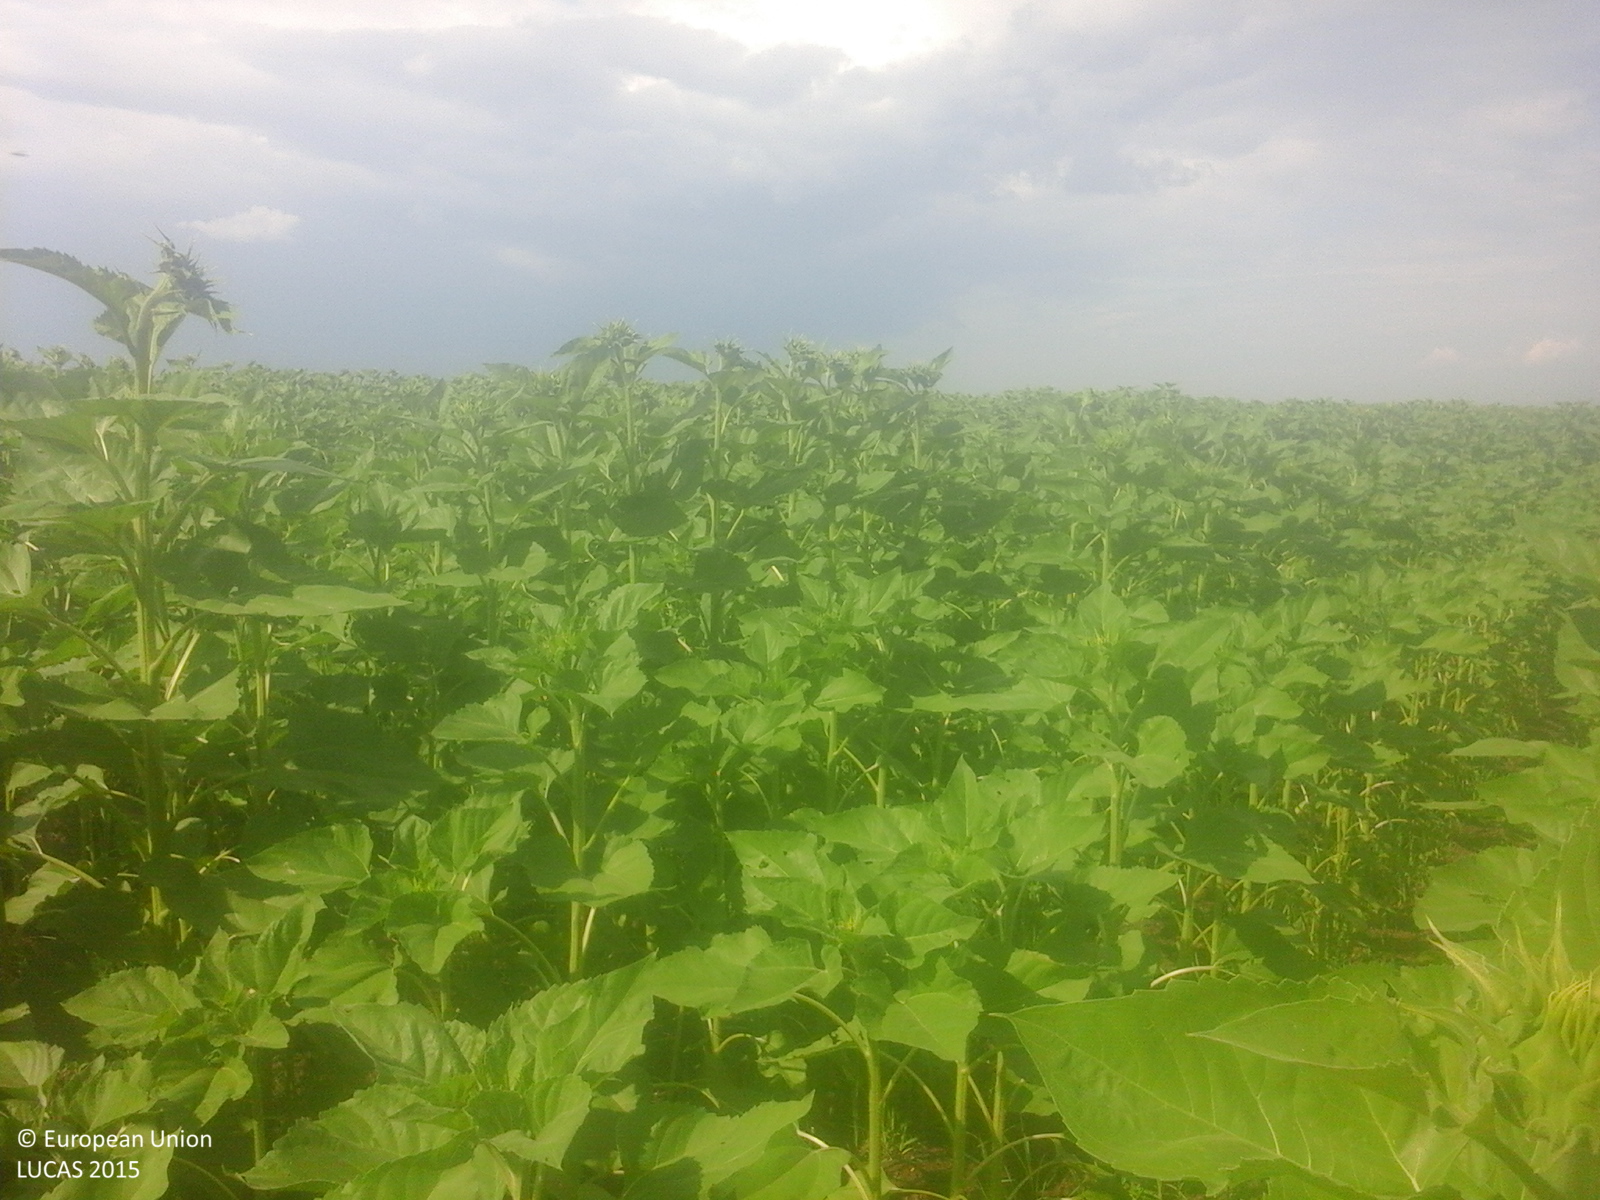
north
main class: Cropland
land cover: Sunflower
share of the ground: > 75 %
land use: Agriculture (excluding fallow land and kitchen gardens)
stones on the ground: < 10 %
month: July
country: RO
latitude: 44.0822
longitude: 25.4596
